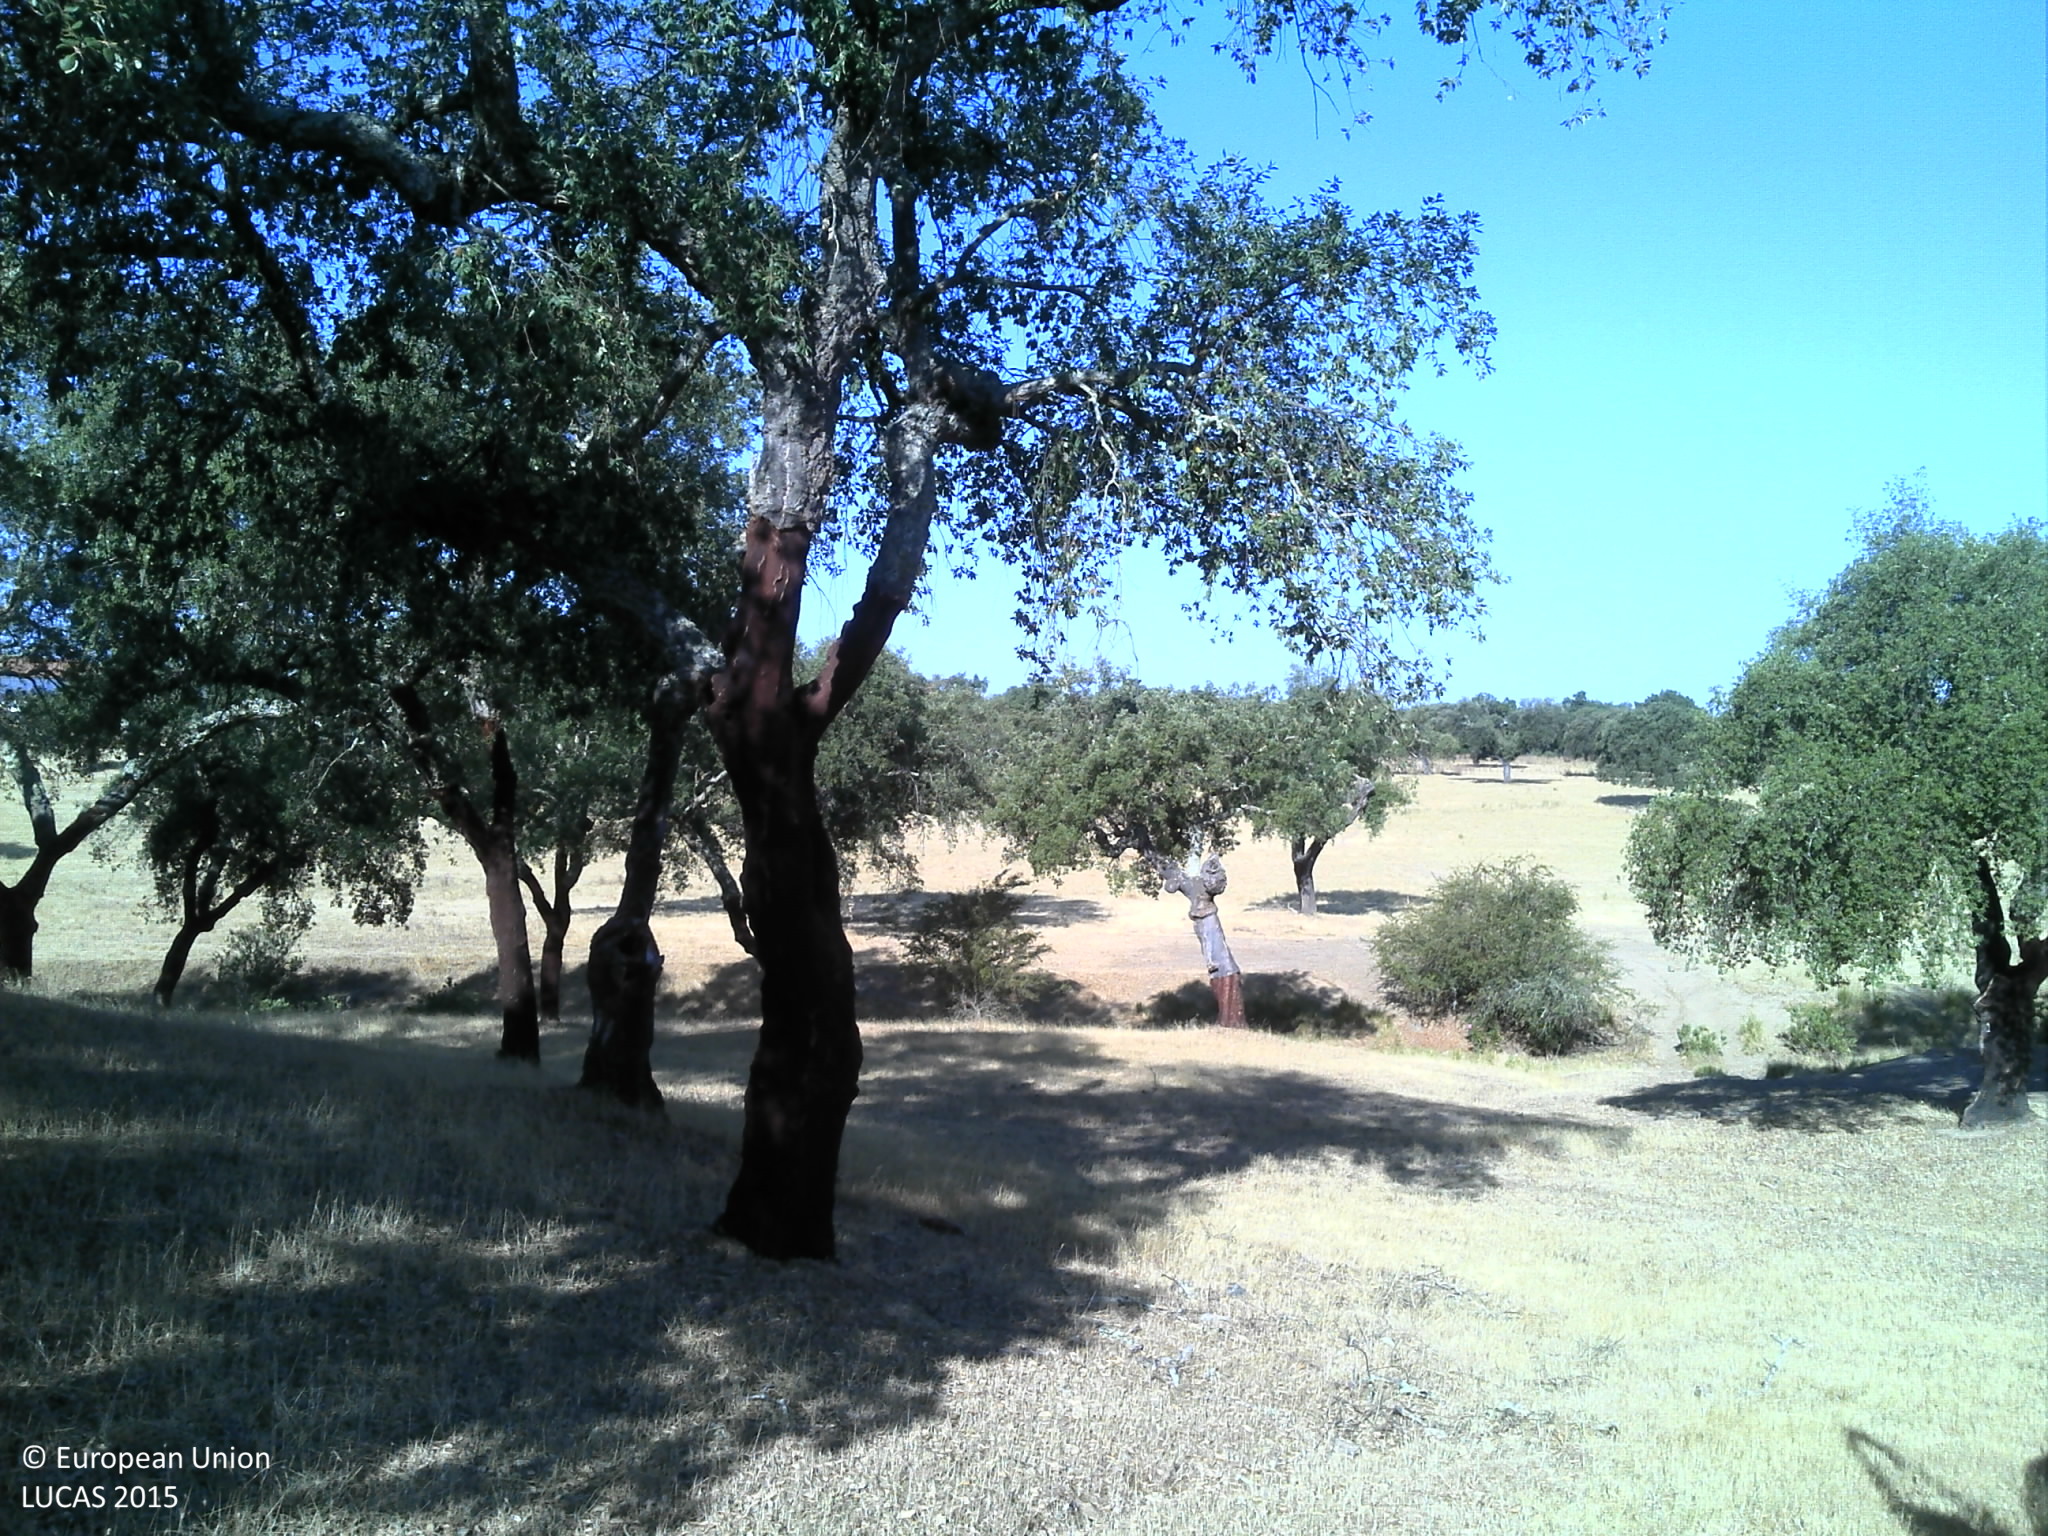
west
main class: Woodland
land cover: Broadleaved woodland
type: broadleaved evergreen forest
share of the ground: 25 - 50 %
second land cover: Grassland without tree/shrub cover
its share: 10 - 25 %
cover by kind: unconsolidated bare surface 50 %, broadleaved forest trees 25 %, herbaceous plants 25 %
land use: Forestry
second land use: Agriculture (excluding fallow land and kitchen gardens)
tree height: > 5 m
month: July
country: PT
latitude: 38.5680
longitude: -7.5098
